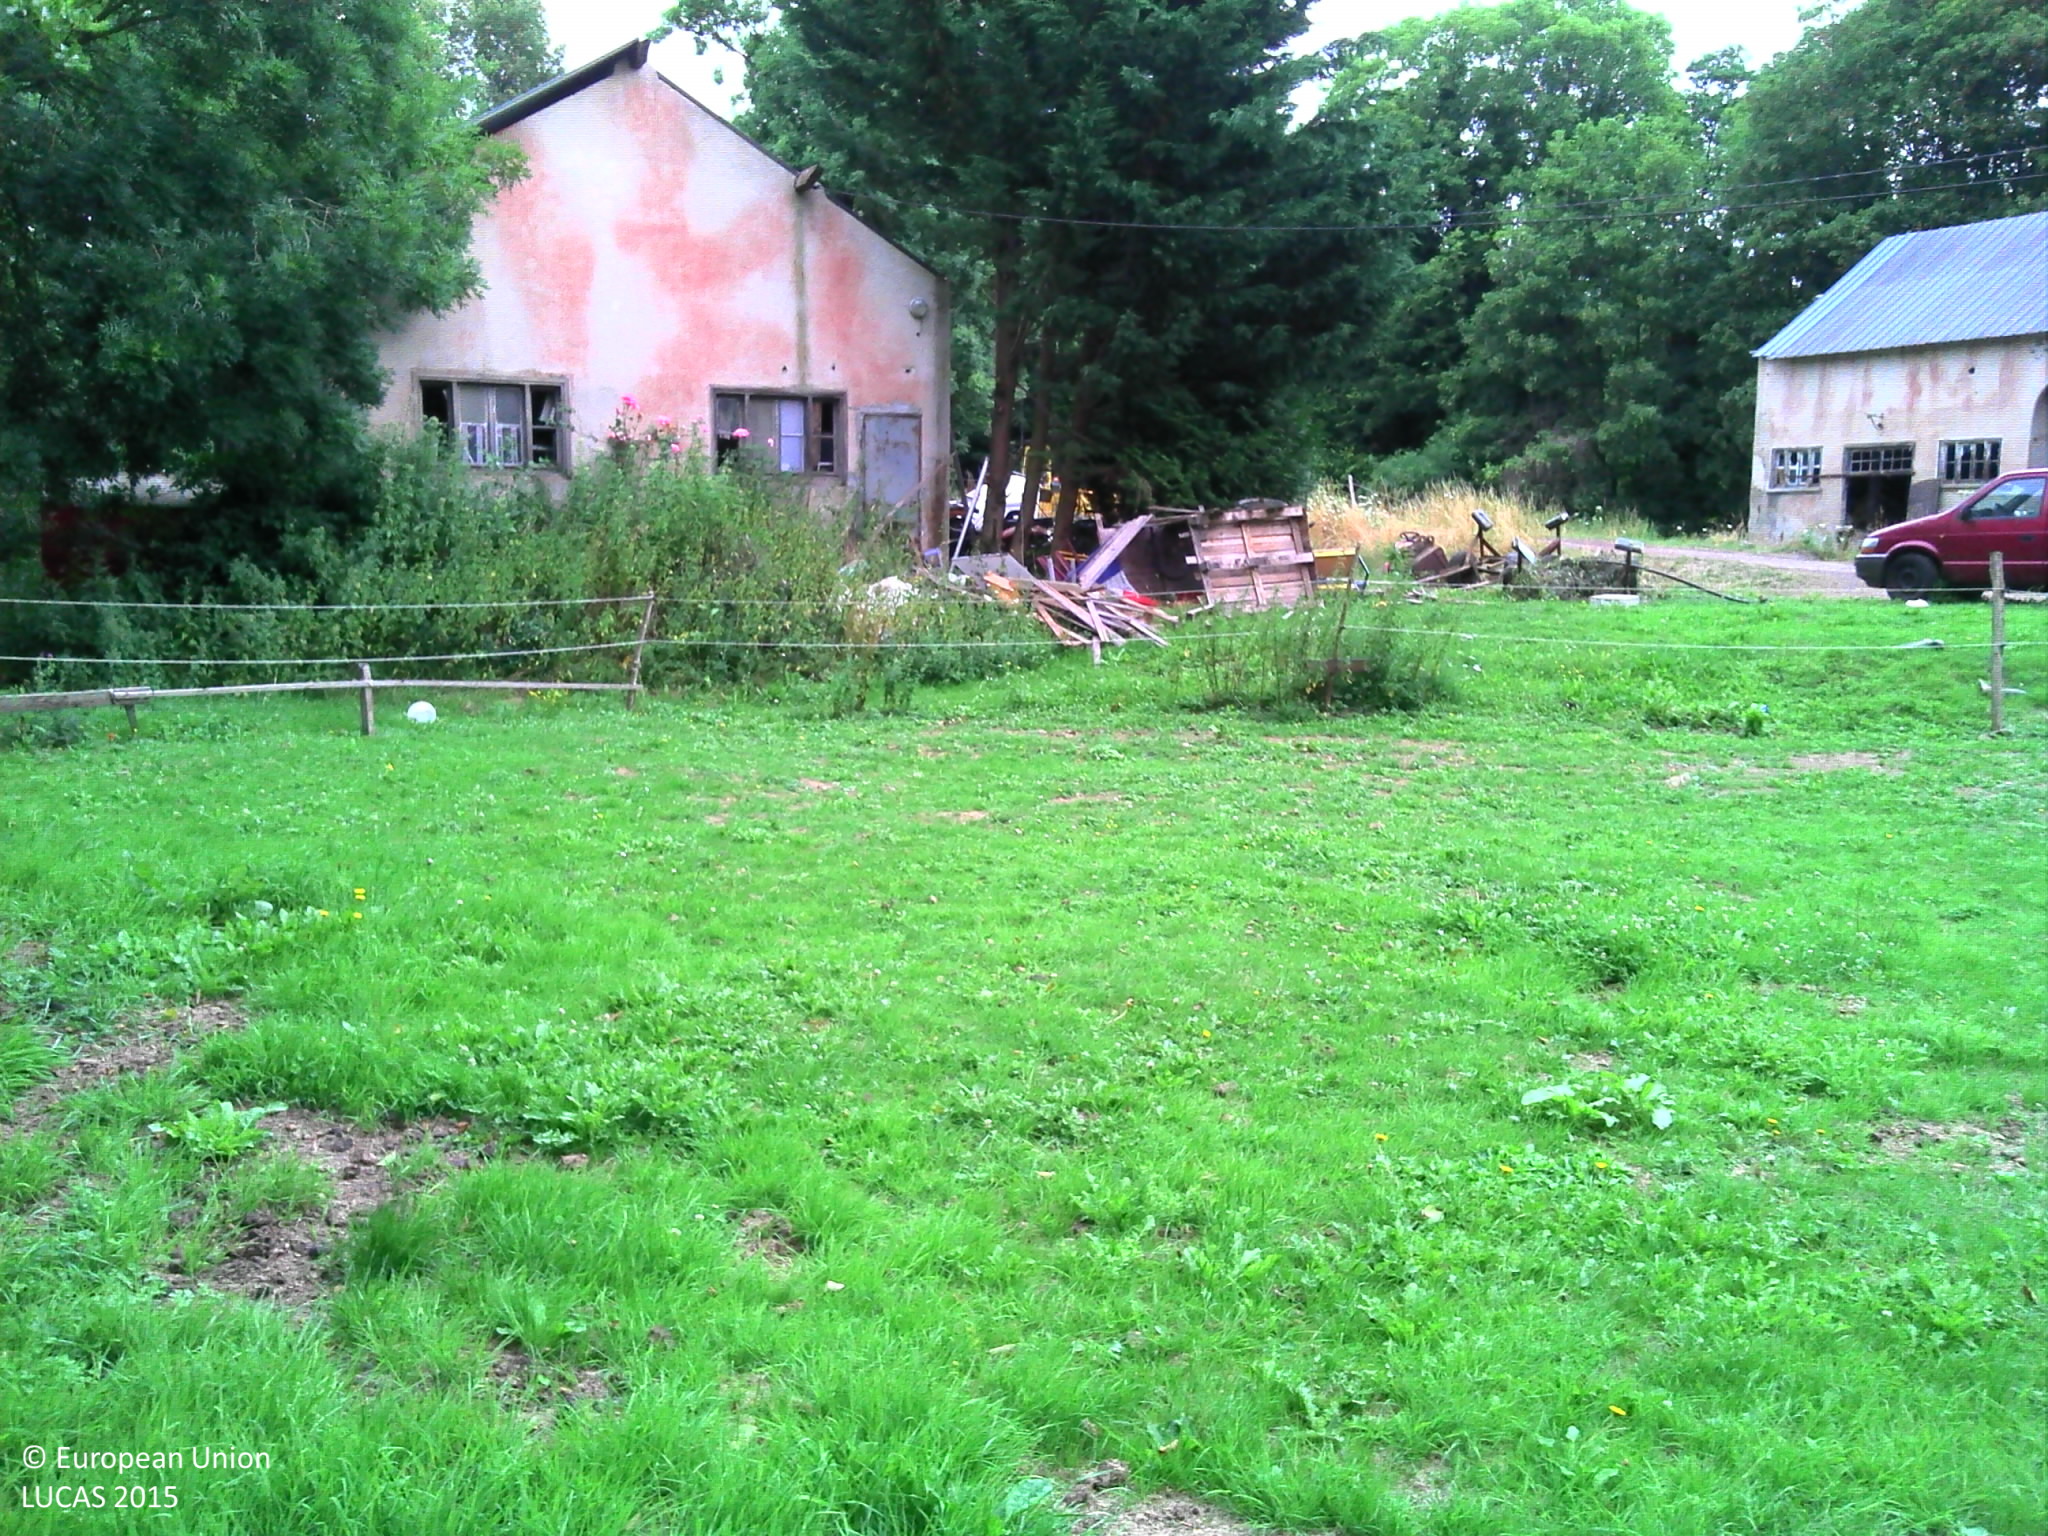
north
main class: Grassland
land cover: Grassland without tree/shrub cover
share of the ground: > 75 %
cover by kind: herbaceous plants 100 %
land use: Residential
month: July
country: FR
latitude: 49.0270
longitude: -0.3048
